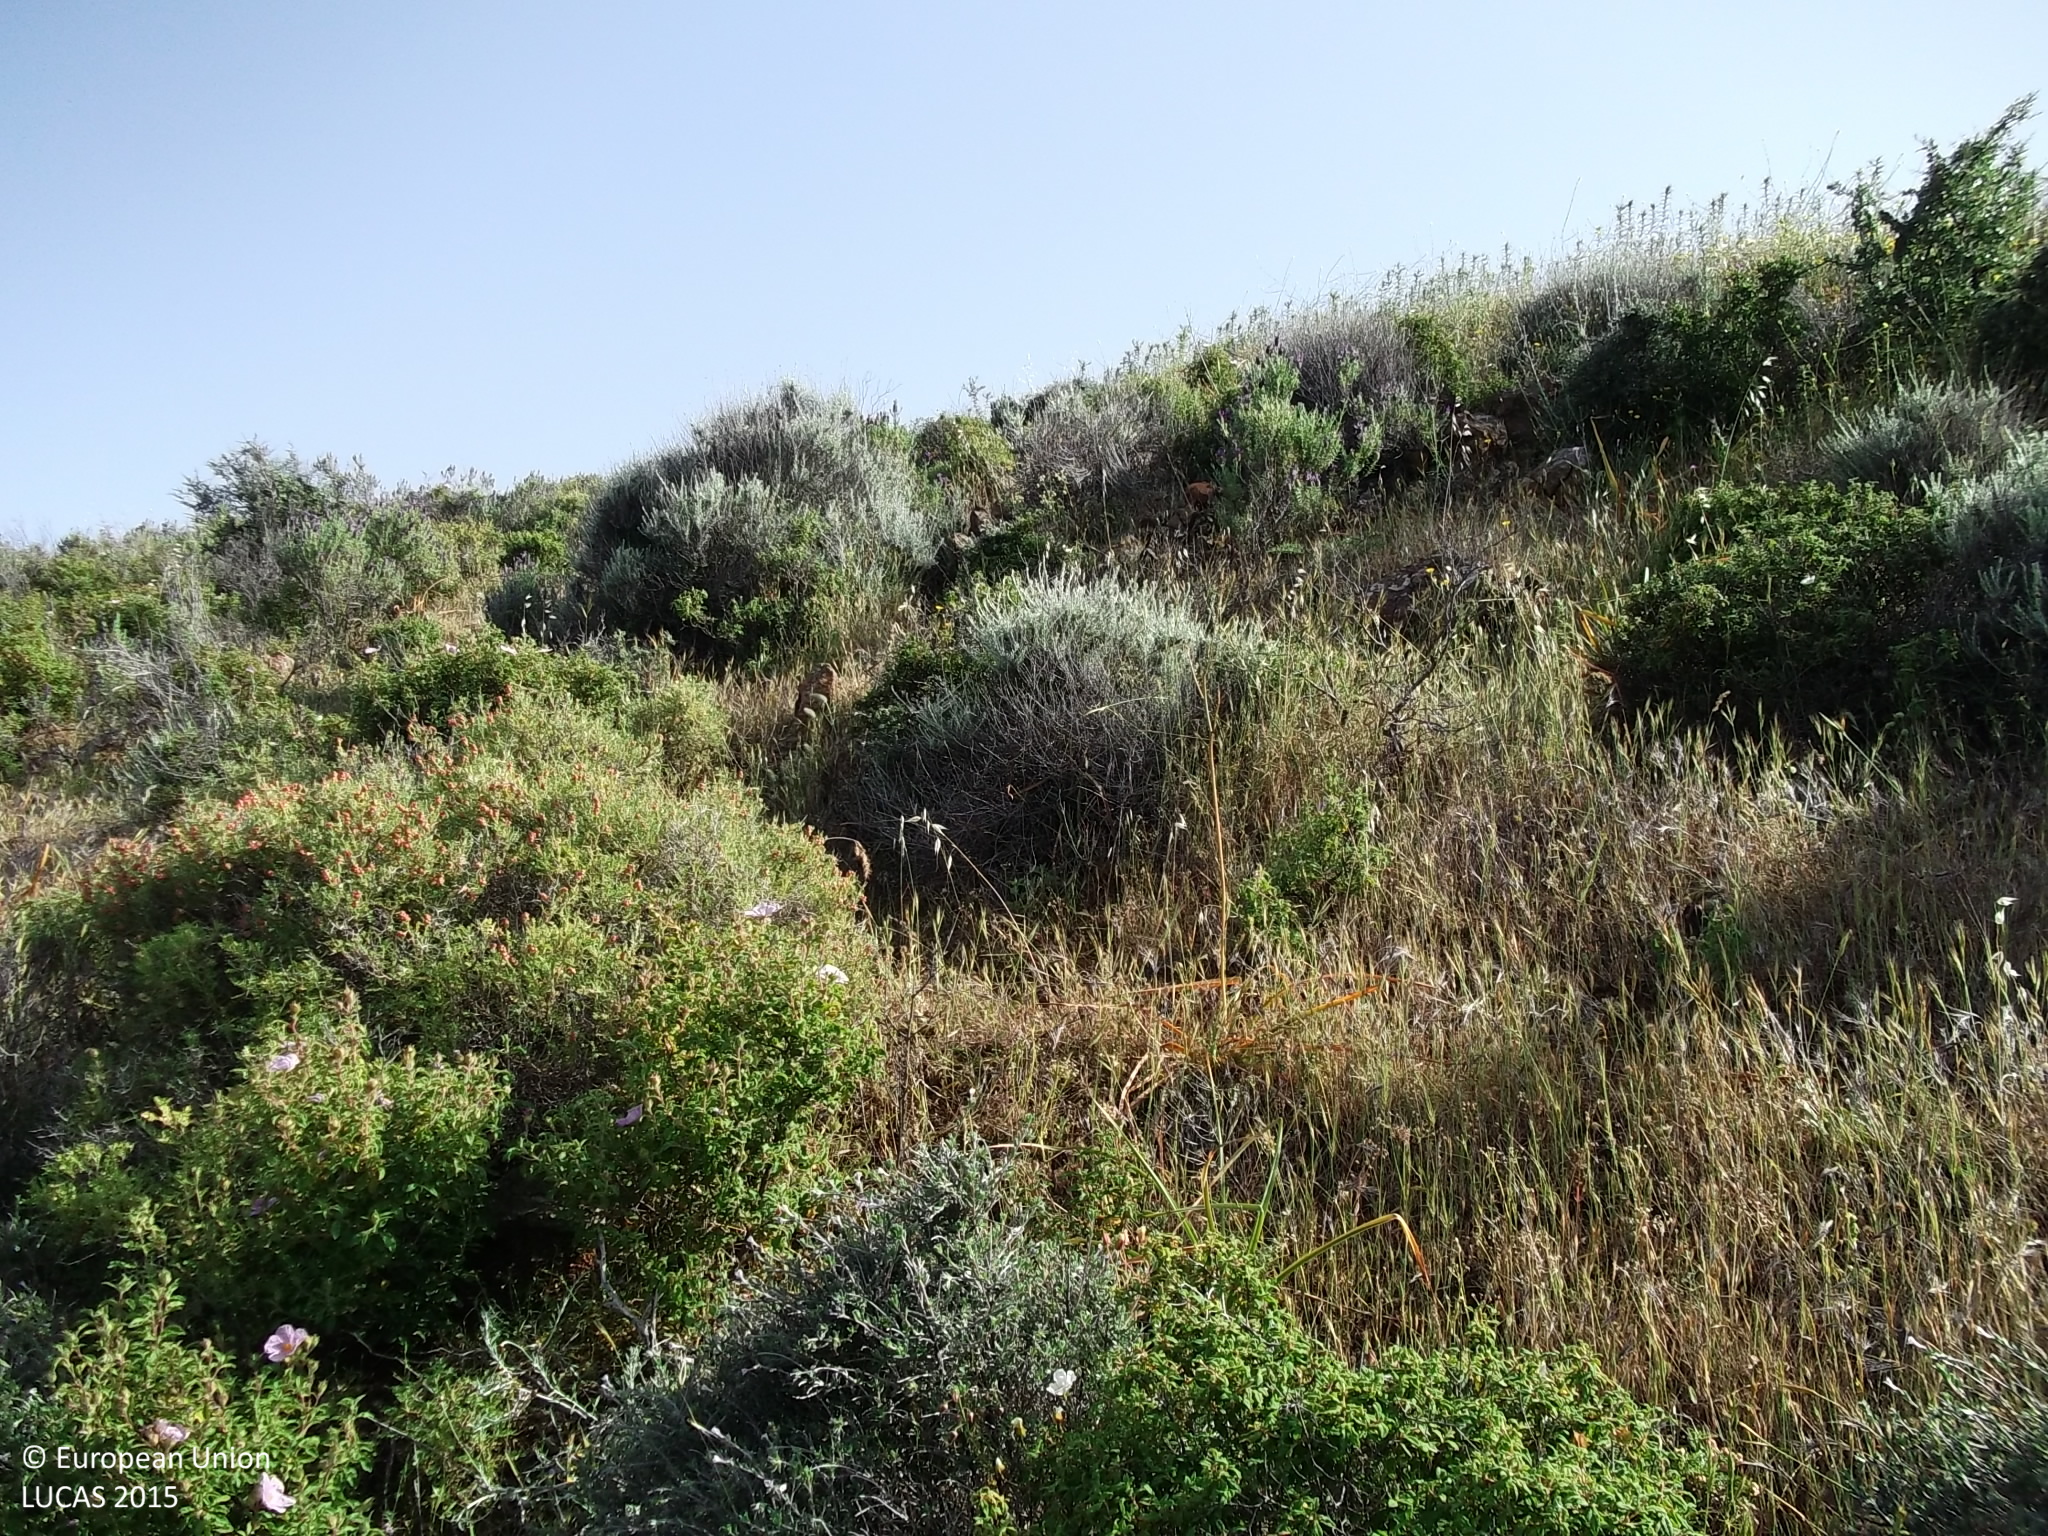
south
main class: Shrubland
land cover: Shrubland without tree cover
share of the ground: > 75 %
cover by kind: shrubs 85 %, herbaceous plants 10 %, unconsolidated bare surface 5 %
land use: Semi-natural and natural areas not in use
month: April
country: CY
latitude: 34.8917
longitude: 33.3490
